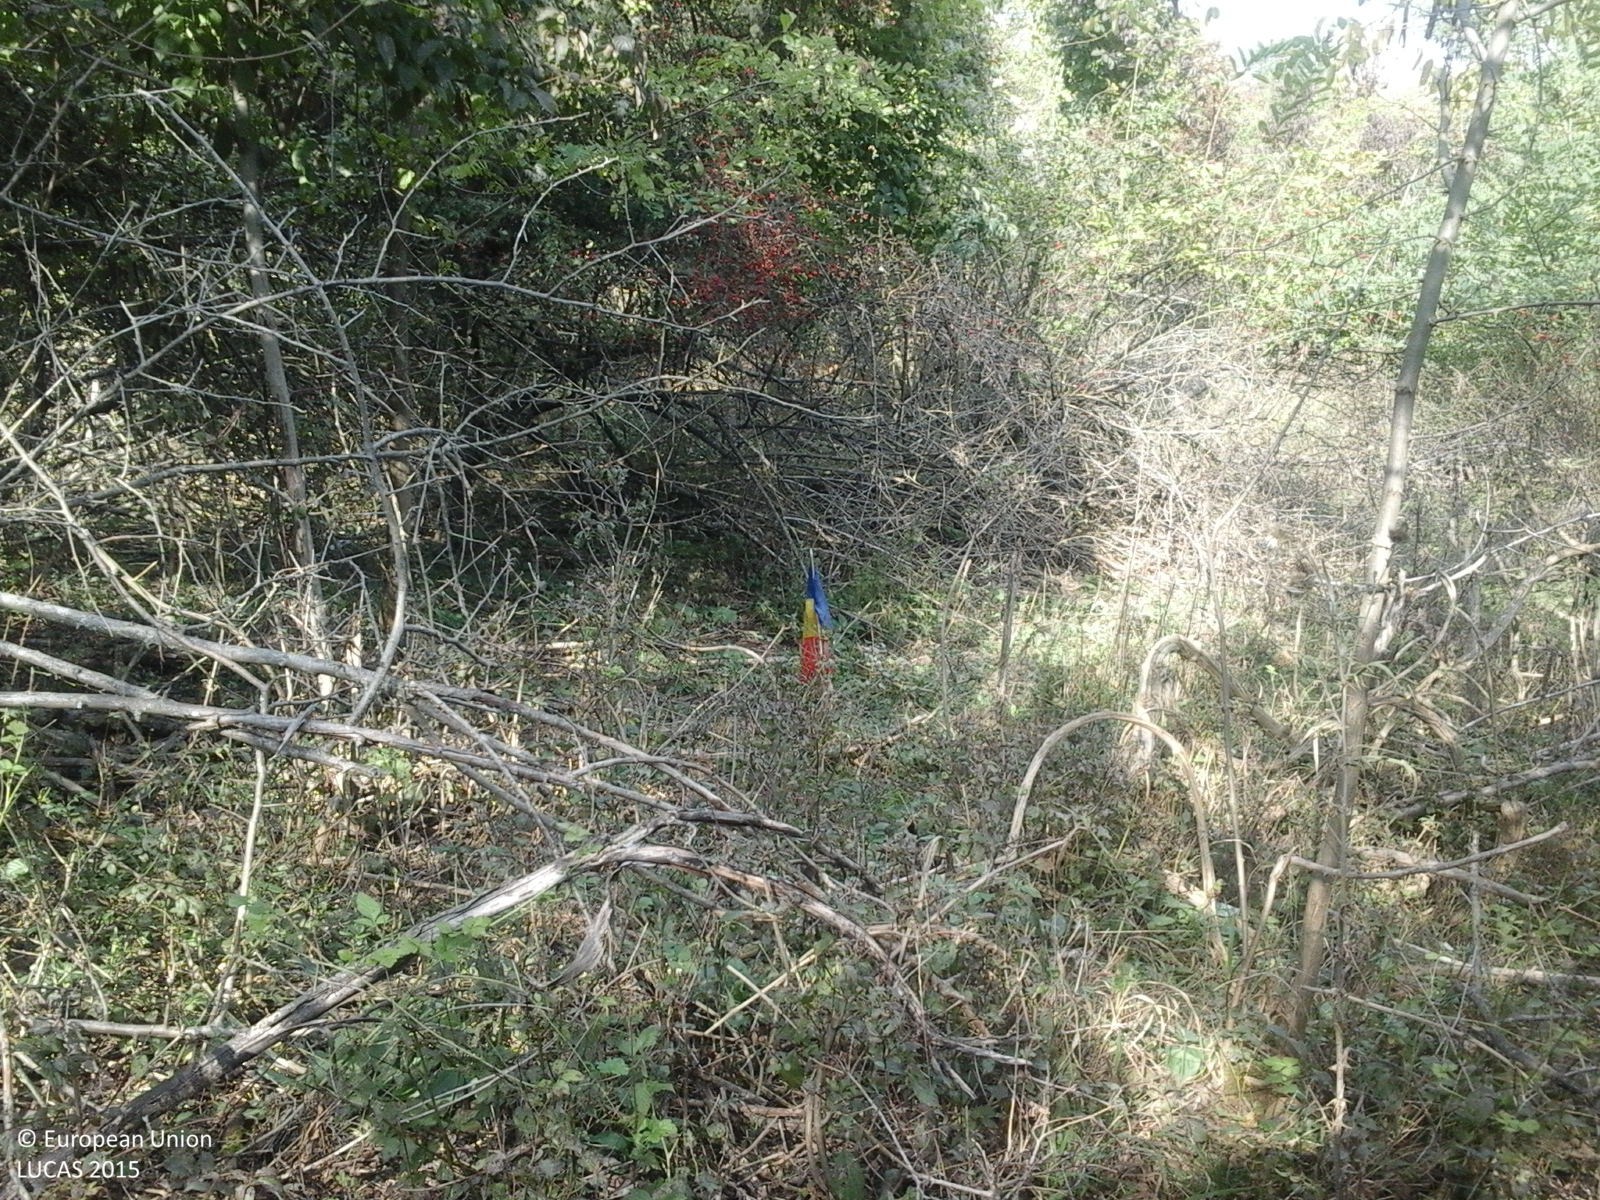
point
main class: Woodland
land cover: Broadleaved woodland
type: exotic forest
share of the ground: > 75 %
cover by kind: broadleaved forest trees 100 %
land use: Forestry
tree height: > 5 m
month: October
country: RO
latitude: 46.4143
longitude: 24.1162
